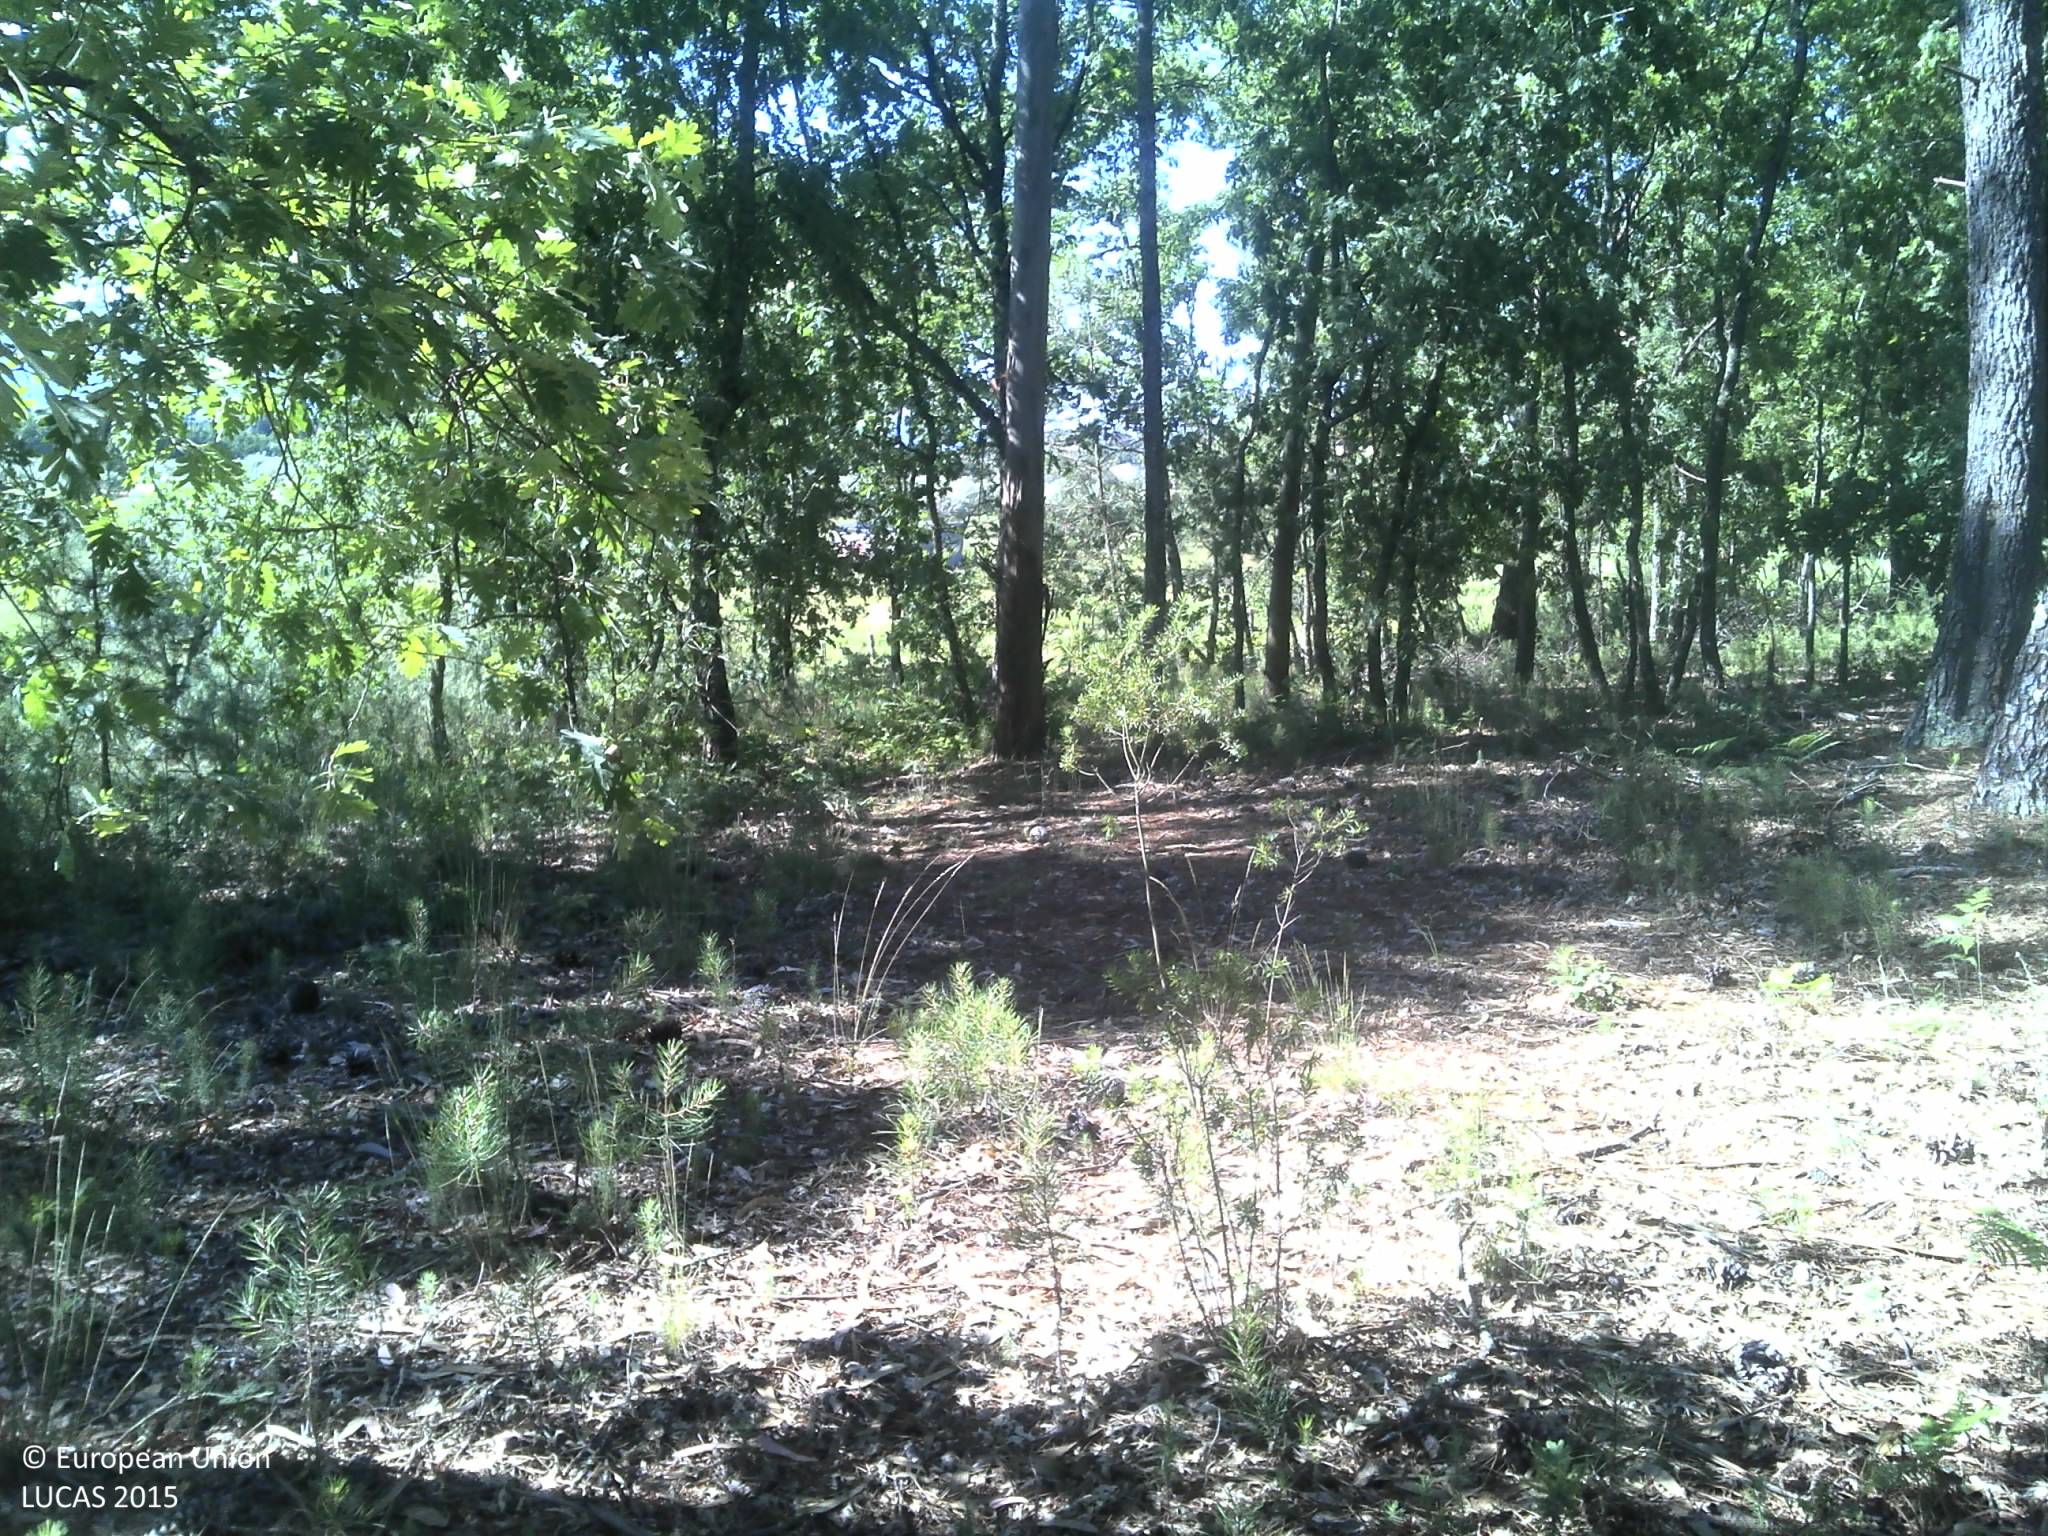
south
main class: Woodland
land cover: Pine dominated coniferous woodland
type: coniferous forest of the mediterranean region
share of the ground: 50 - 75 %
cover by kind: coniferous forest trees 70 %, shrubs 20 %, unconsolidated bare surface 10 %
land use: Forestry
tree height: > 5 m
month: May
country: PT
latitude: 40.4628
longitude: -7.7476
